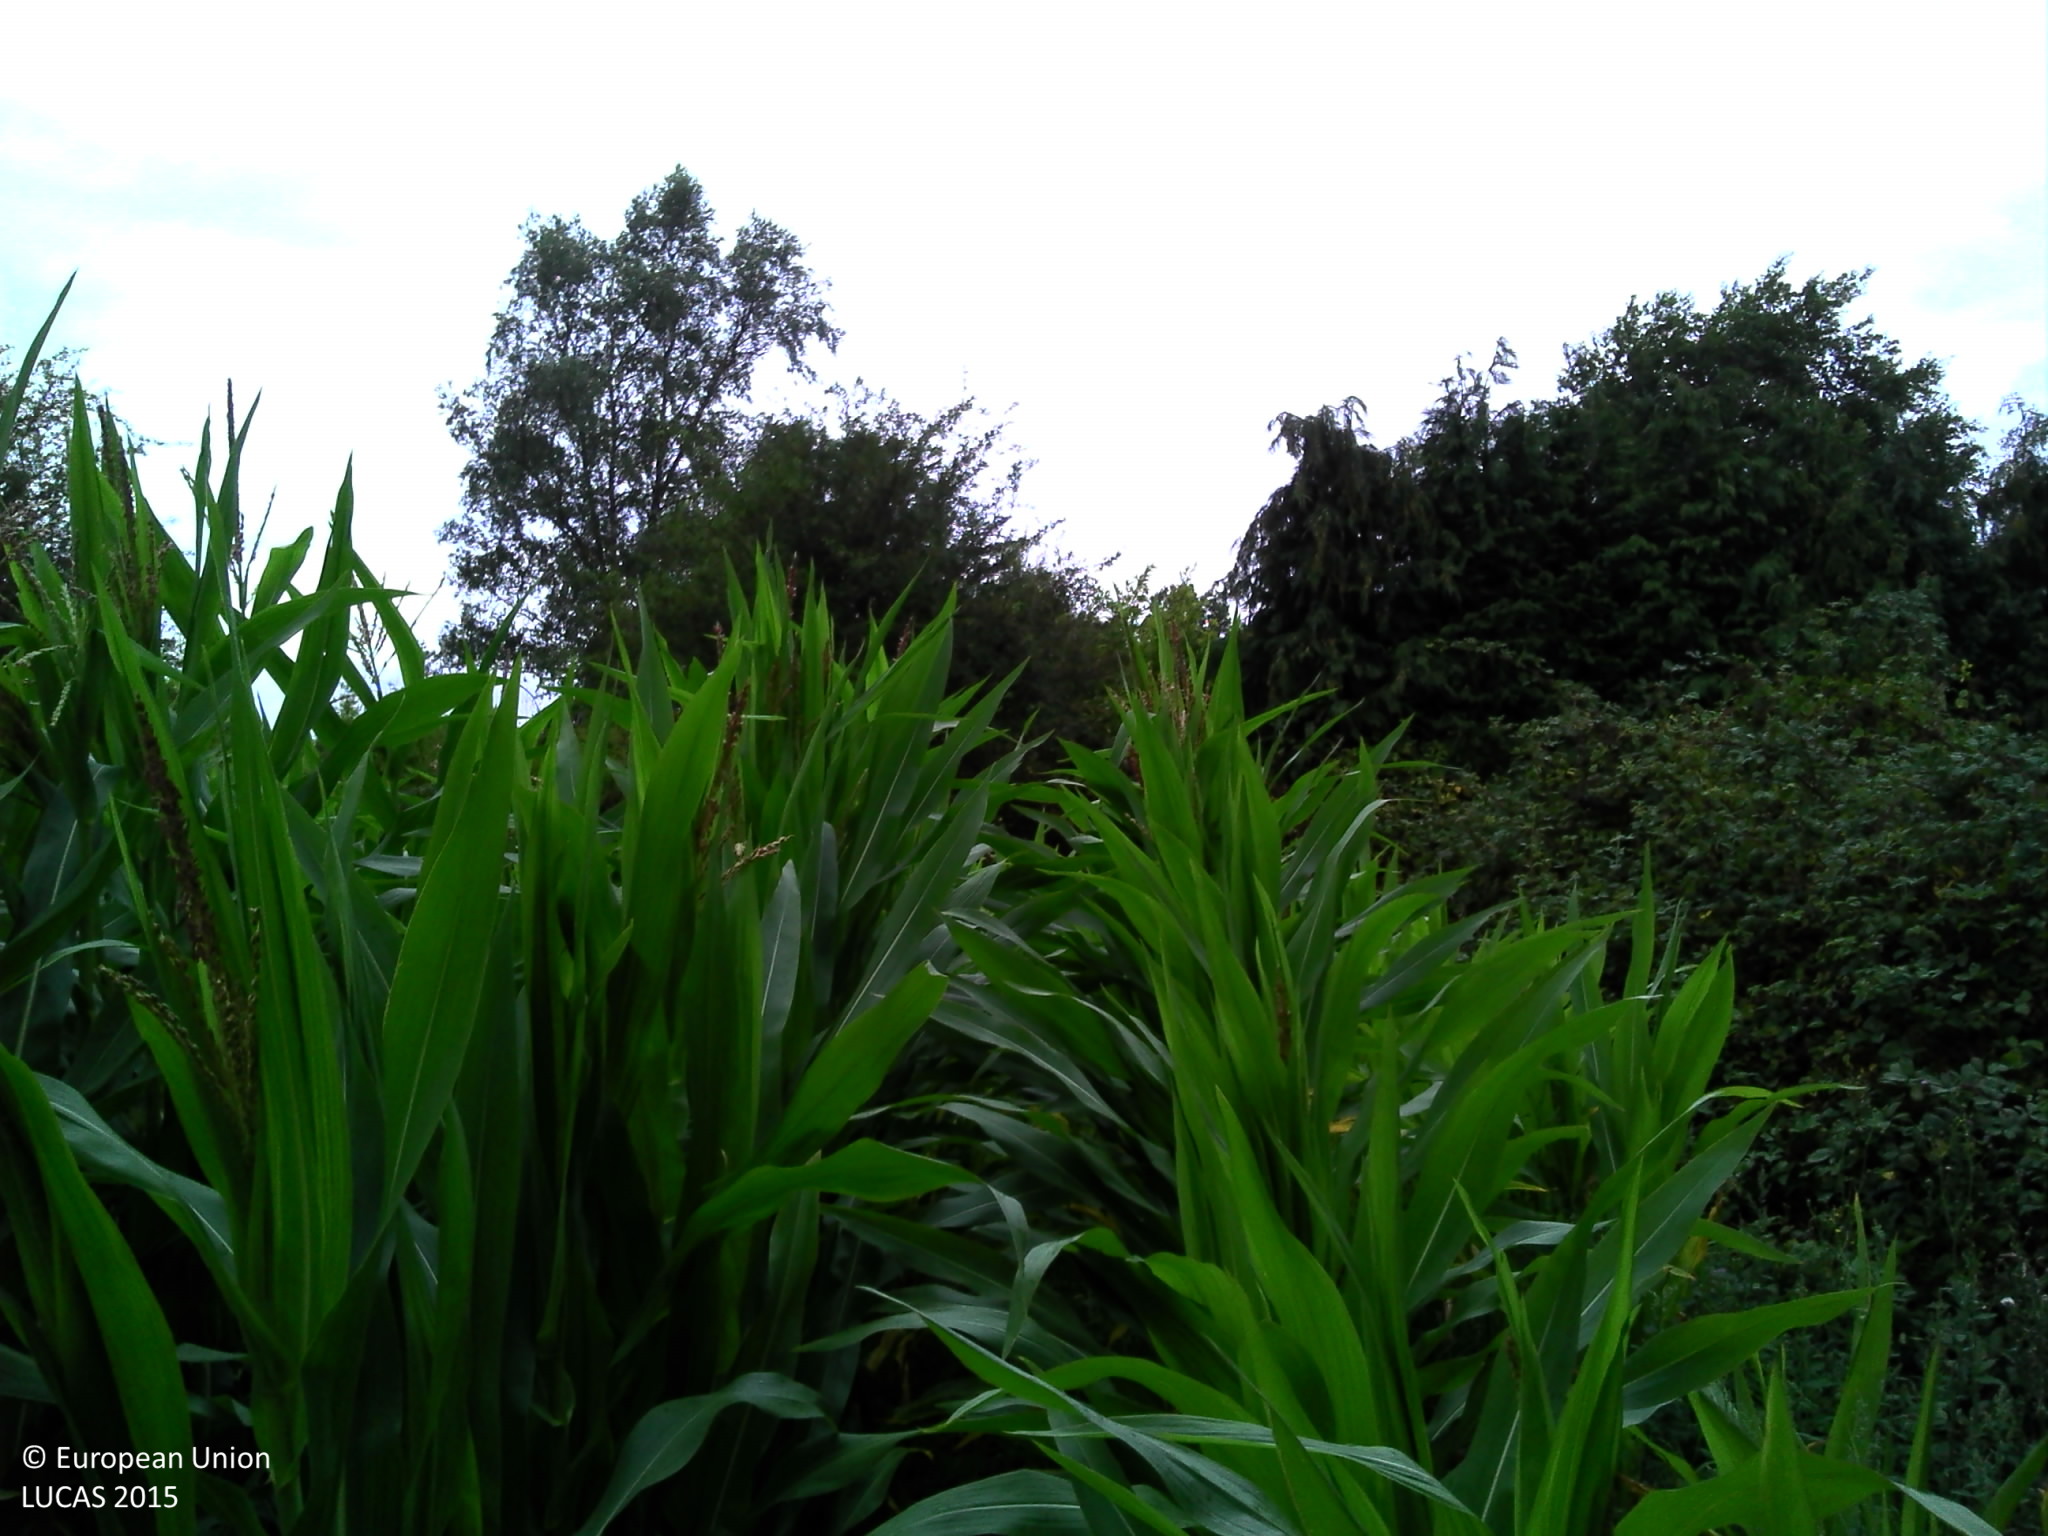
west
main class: Cropland
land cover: Maize
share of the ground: 50 - 75 %
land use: Agriculture (excluding fallow land and kitchen gardens)
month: July
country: FR
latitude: 47.4974
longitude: -1.9562
